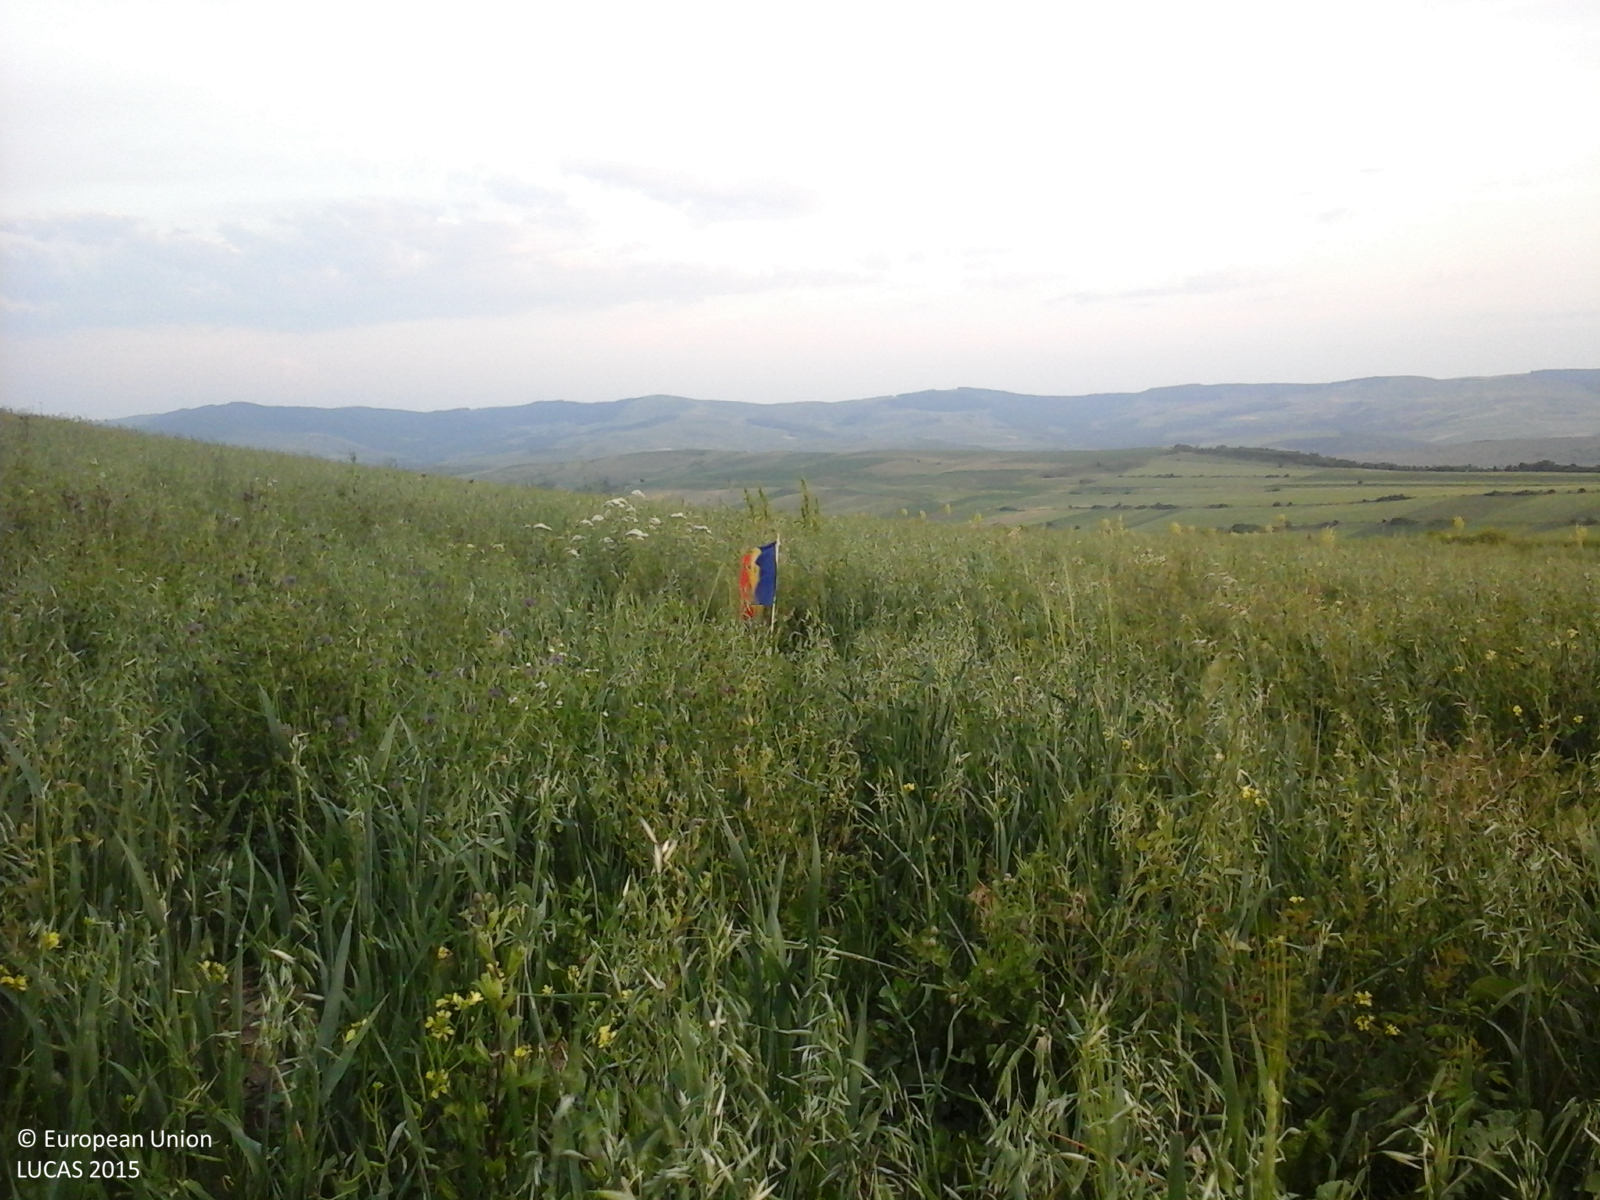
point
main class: Cropland
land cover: Oats
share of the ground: > 75 %
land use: Agriculture (excluding fallow land and kitchen gardens)
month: June
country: RO
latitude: 46.6822
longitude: 27.4870
